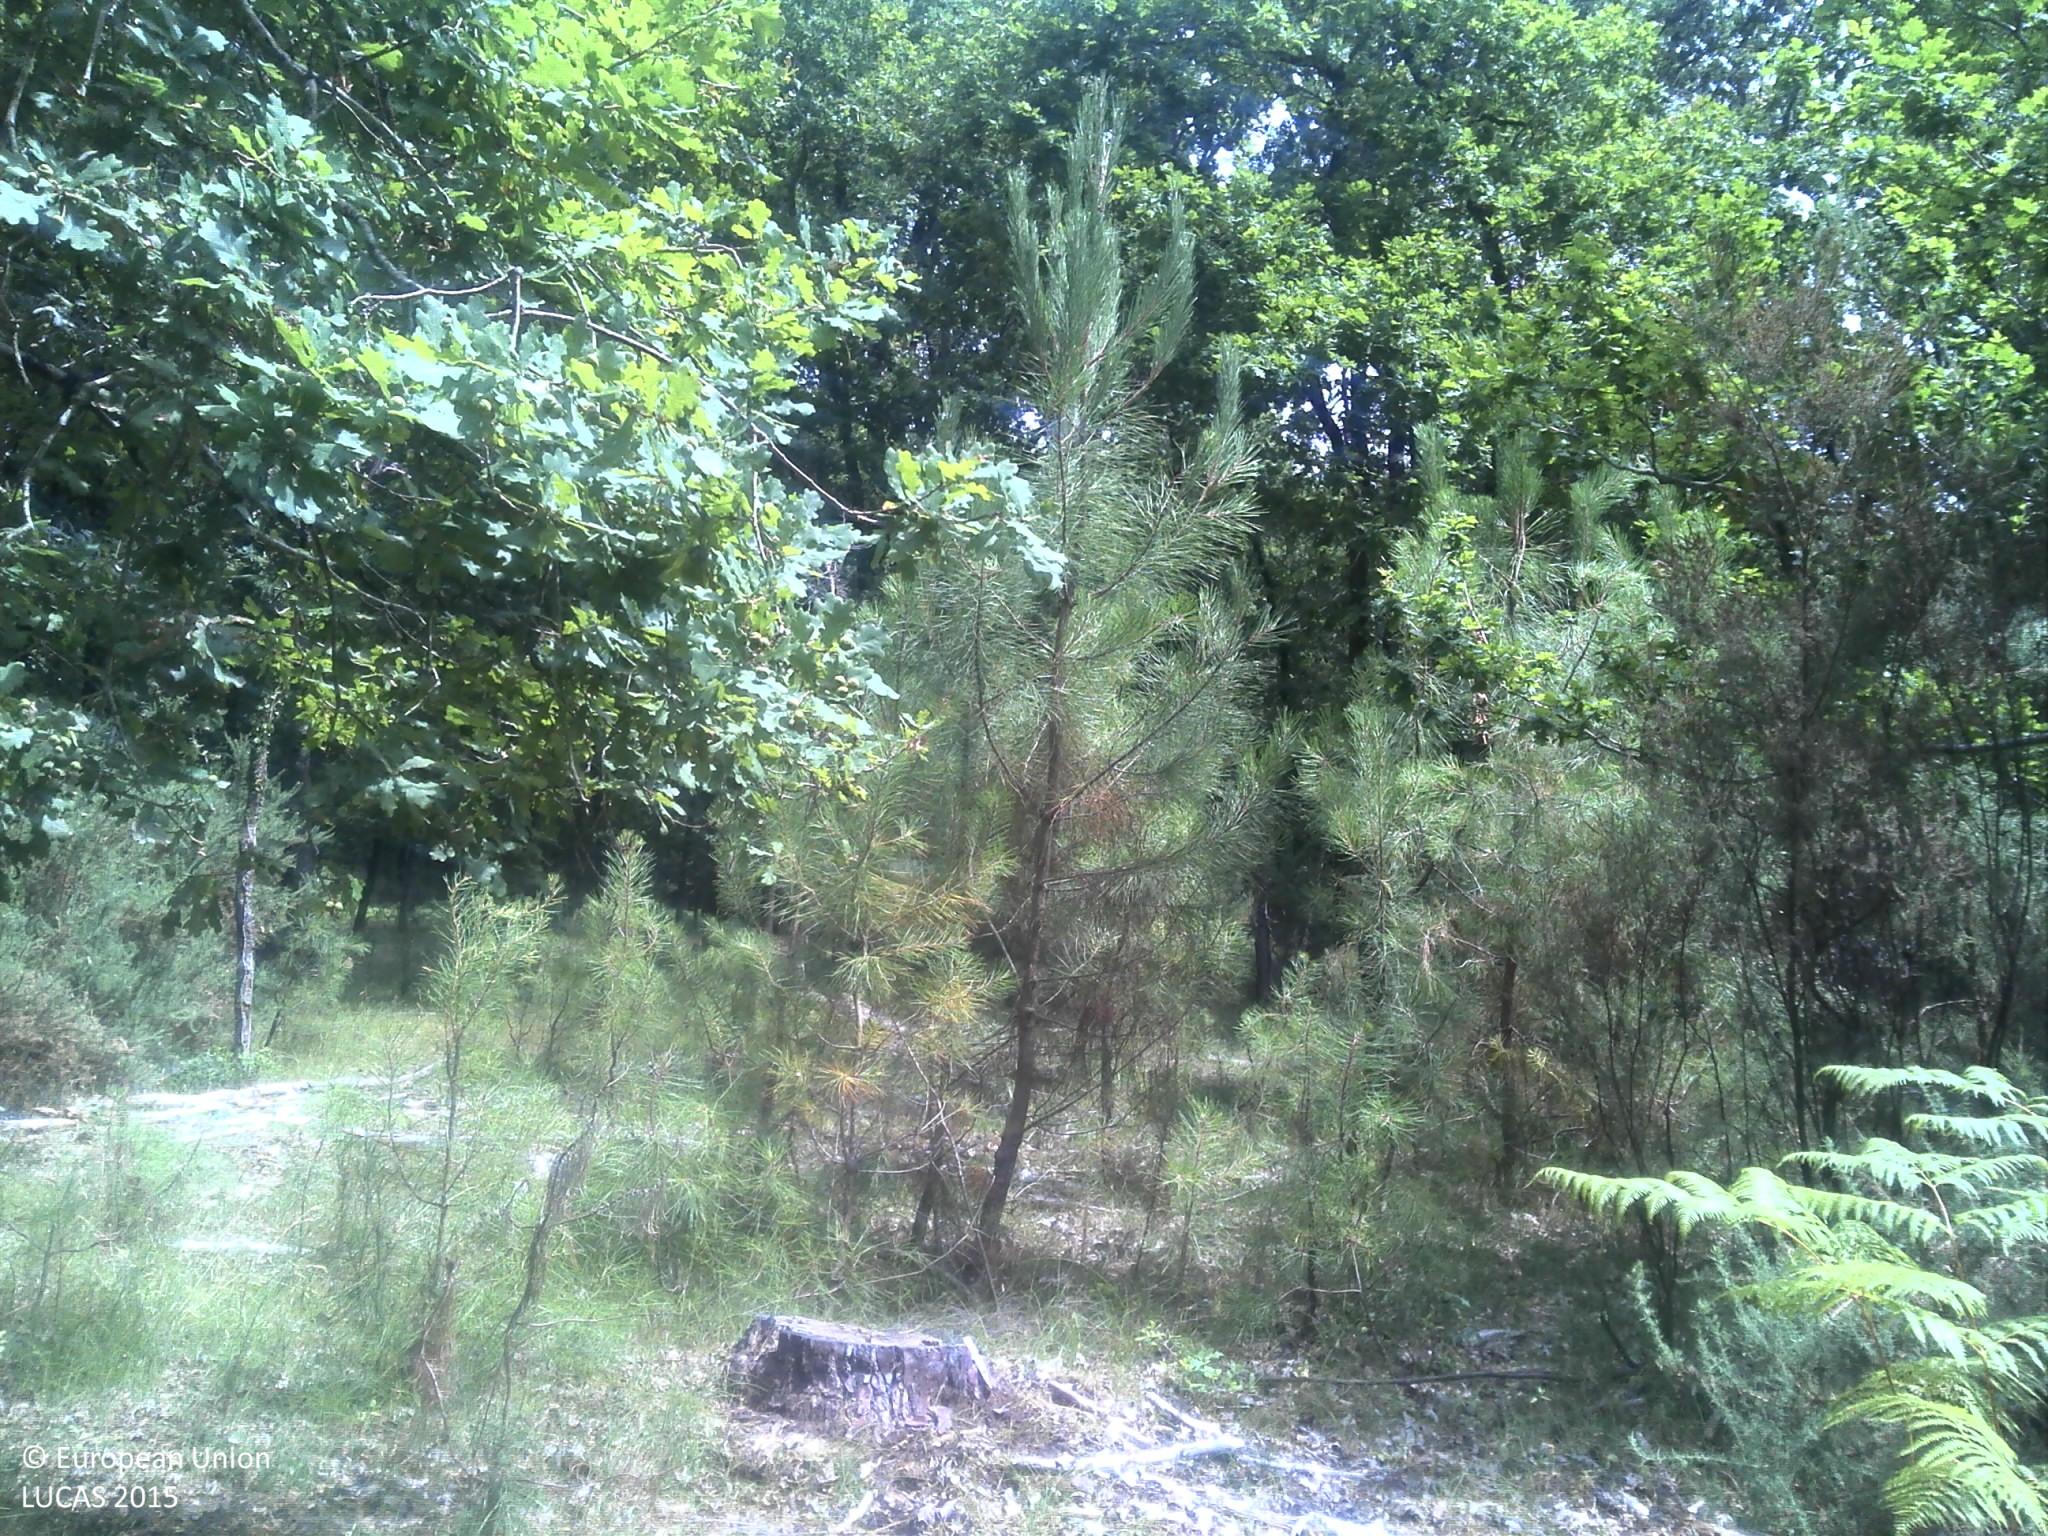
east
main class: Woodland
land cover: Pine dominated mixed woodland
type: coniferous forest of the mediterranean region
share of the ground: > 75 %
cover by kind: broadleaved forest trees 45 %, shrubs 20 %, coniferous forest trees 15 %, herbaceous plants 10 %, consolidated bare surface 10 %
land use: Forestry
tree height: > 5 m
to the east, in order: Pine dominated mixed woodland; Tracks; Pine dominated mixed woodland; Ditches and canals; Pine dominated mixed woodland
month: July
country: FR
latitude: 45.3871
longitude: -1.1263
